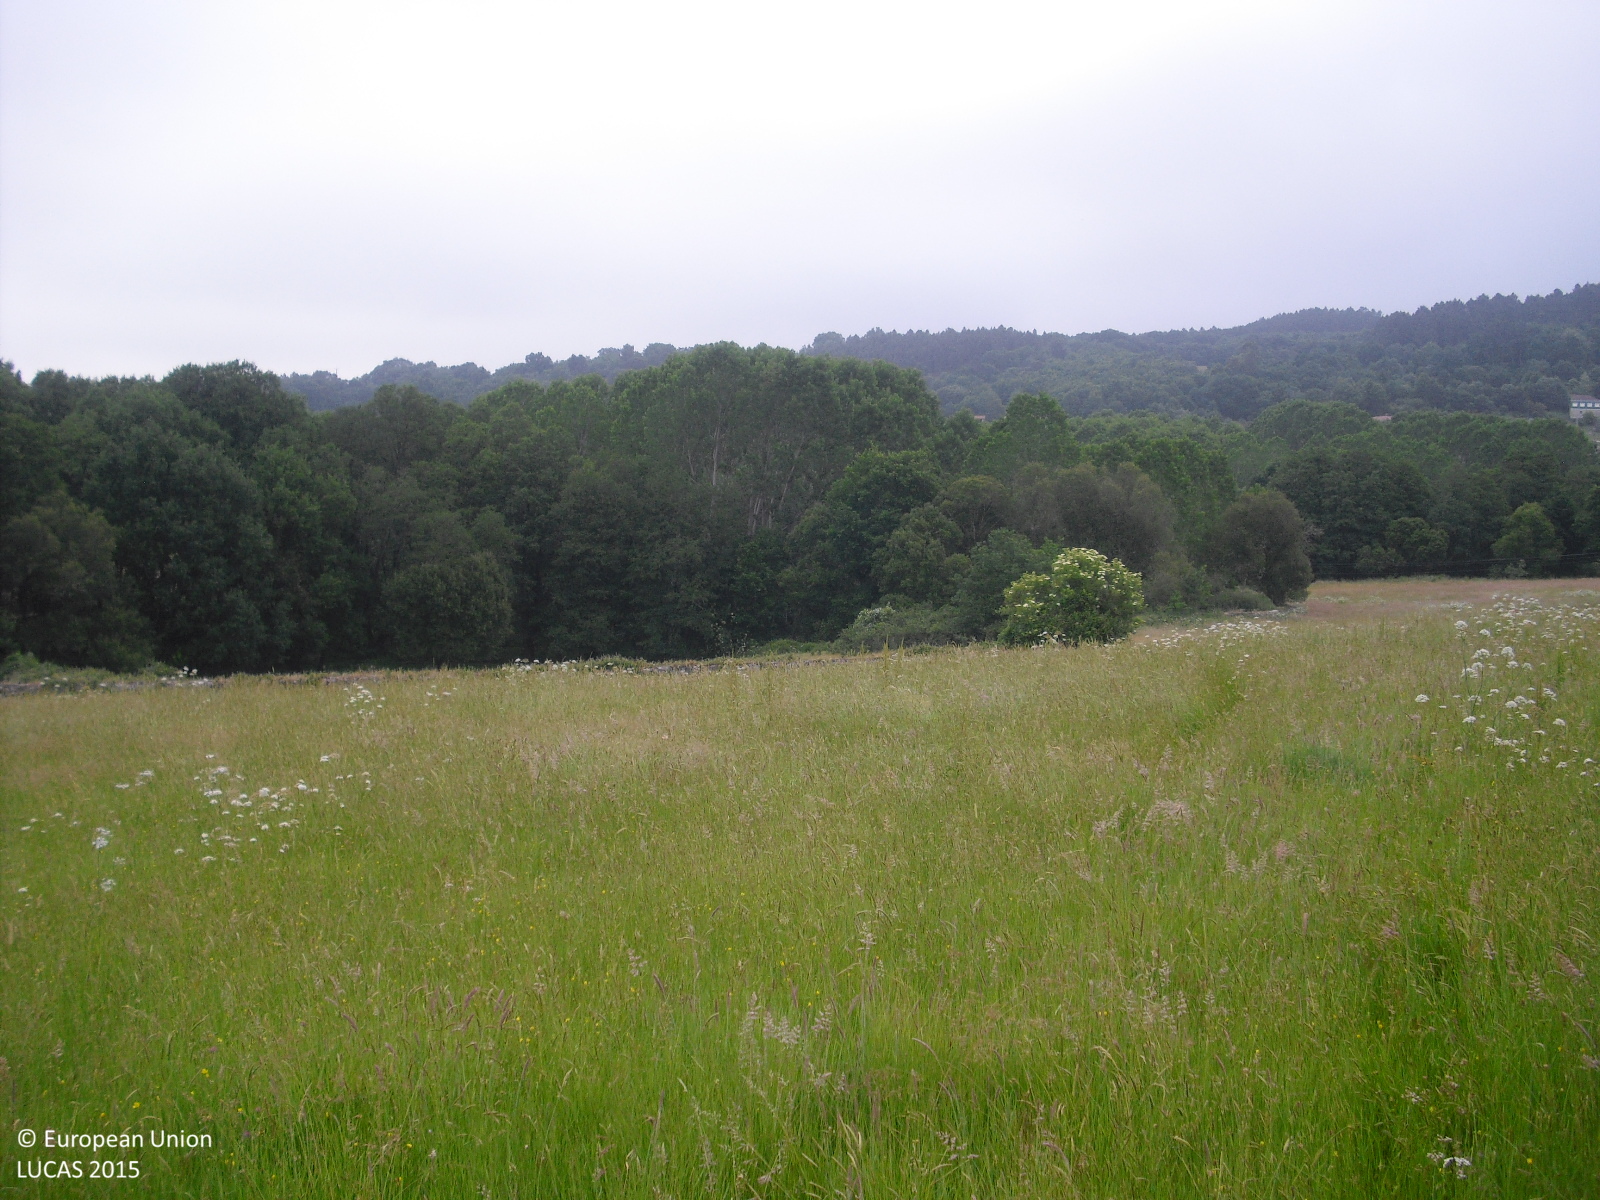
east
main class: Grassland
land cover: Grassland without tree/shrub cover
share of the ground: > 75 %
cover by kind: herbaceous plants 100 %
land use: Agriculture (excluding fallow land and kitchen gardens)
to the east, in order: Grassland without tree/shrub cover; Dry stone walls; Shruby margins; Grassland without tree/shrub cover; Shrubland without tree cover; Dry stone walls; Broadleaved woodland; Shrubland without tree cover; Rivers and streams; Broadleaved woodland; Shrubland without tree cover; Electric lines; Grassland without tree/shrub cover; Tracks; Grassland without tree/shrub cover; Abandoned hedges; Dry stone walls; Abandoned hedges
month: May
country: ES
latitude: 42.1940
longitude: -7.7645
